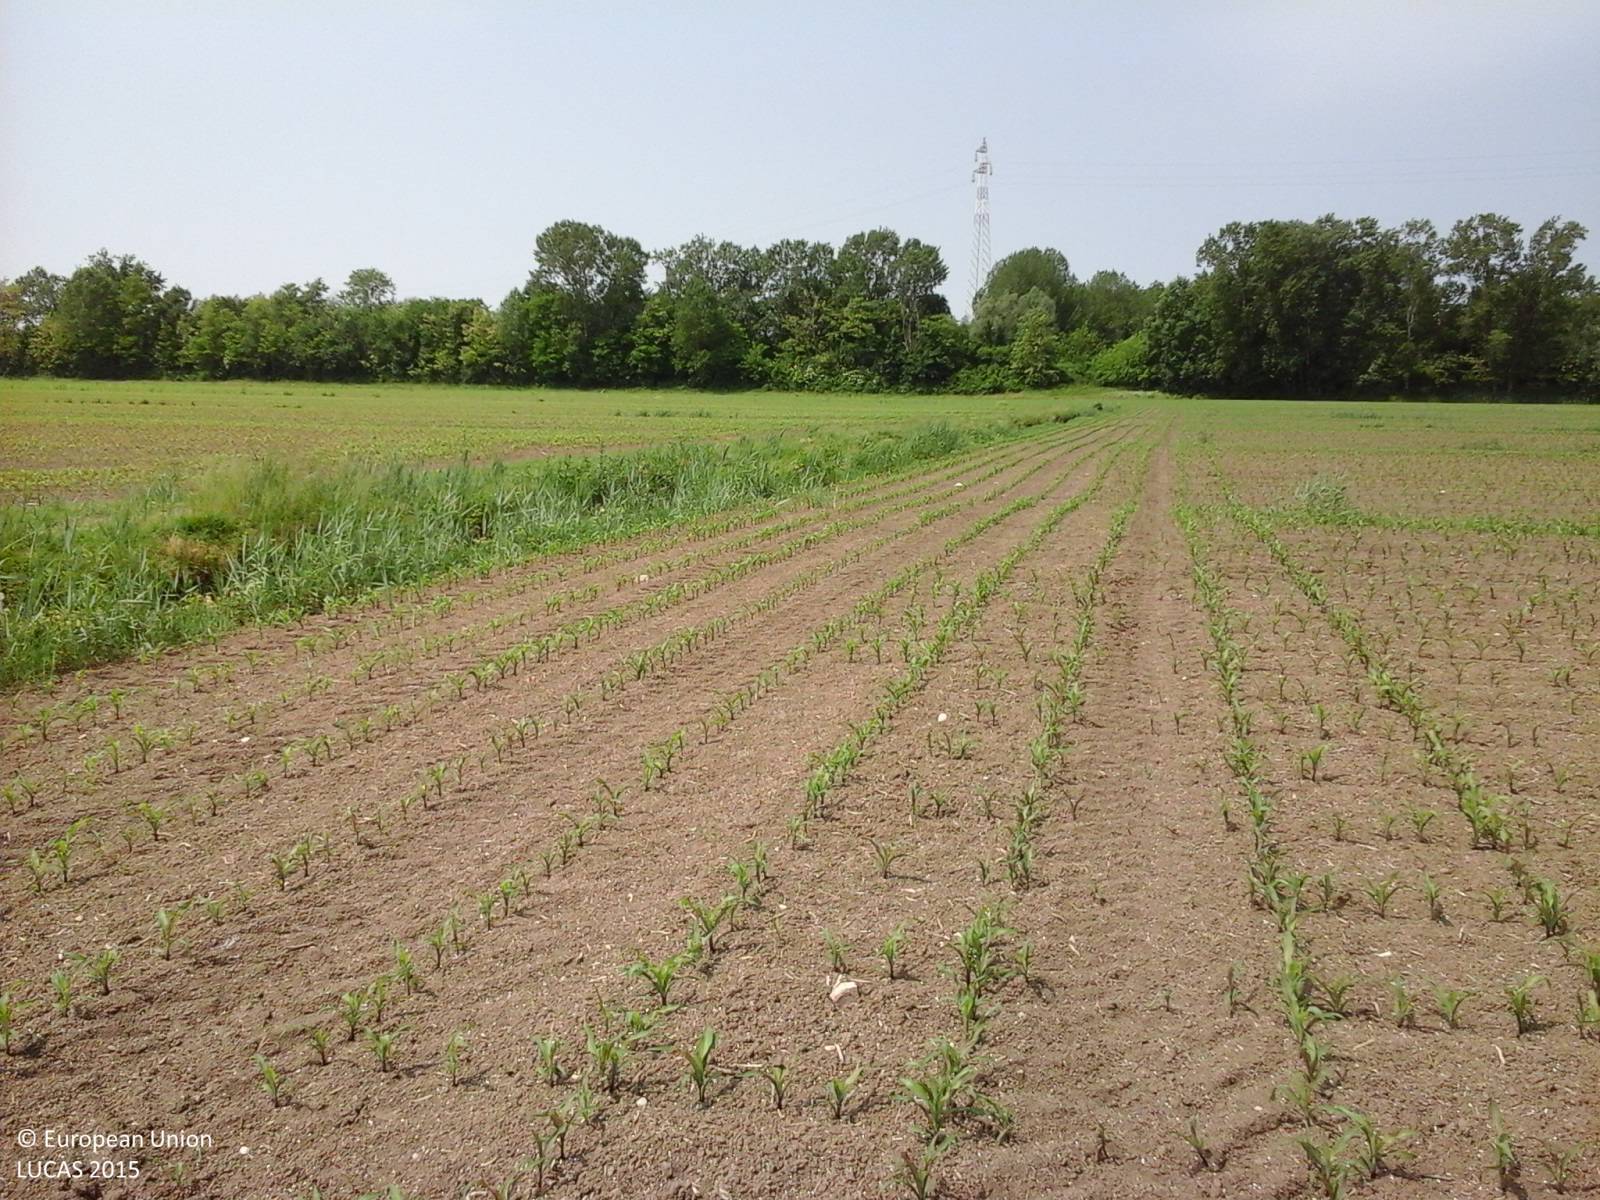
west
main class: Cropland
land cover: Maize
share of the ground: < 10 %
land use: Agriculture (excluding fallow land and kitchen gardens)
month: May
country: IT
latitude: 45.8134
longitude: 13.3034
